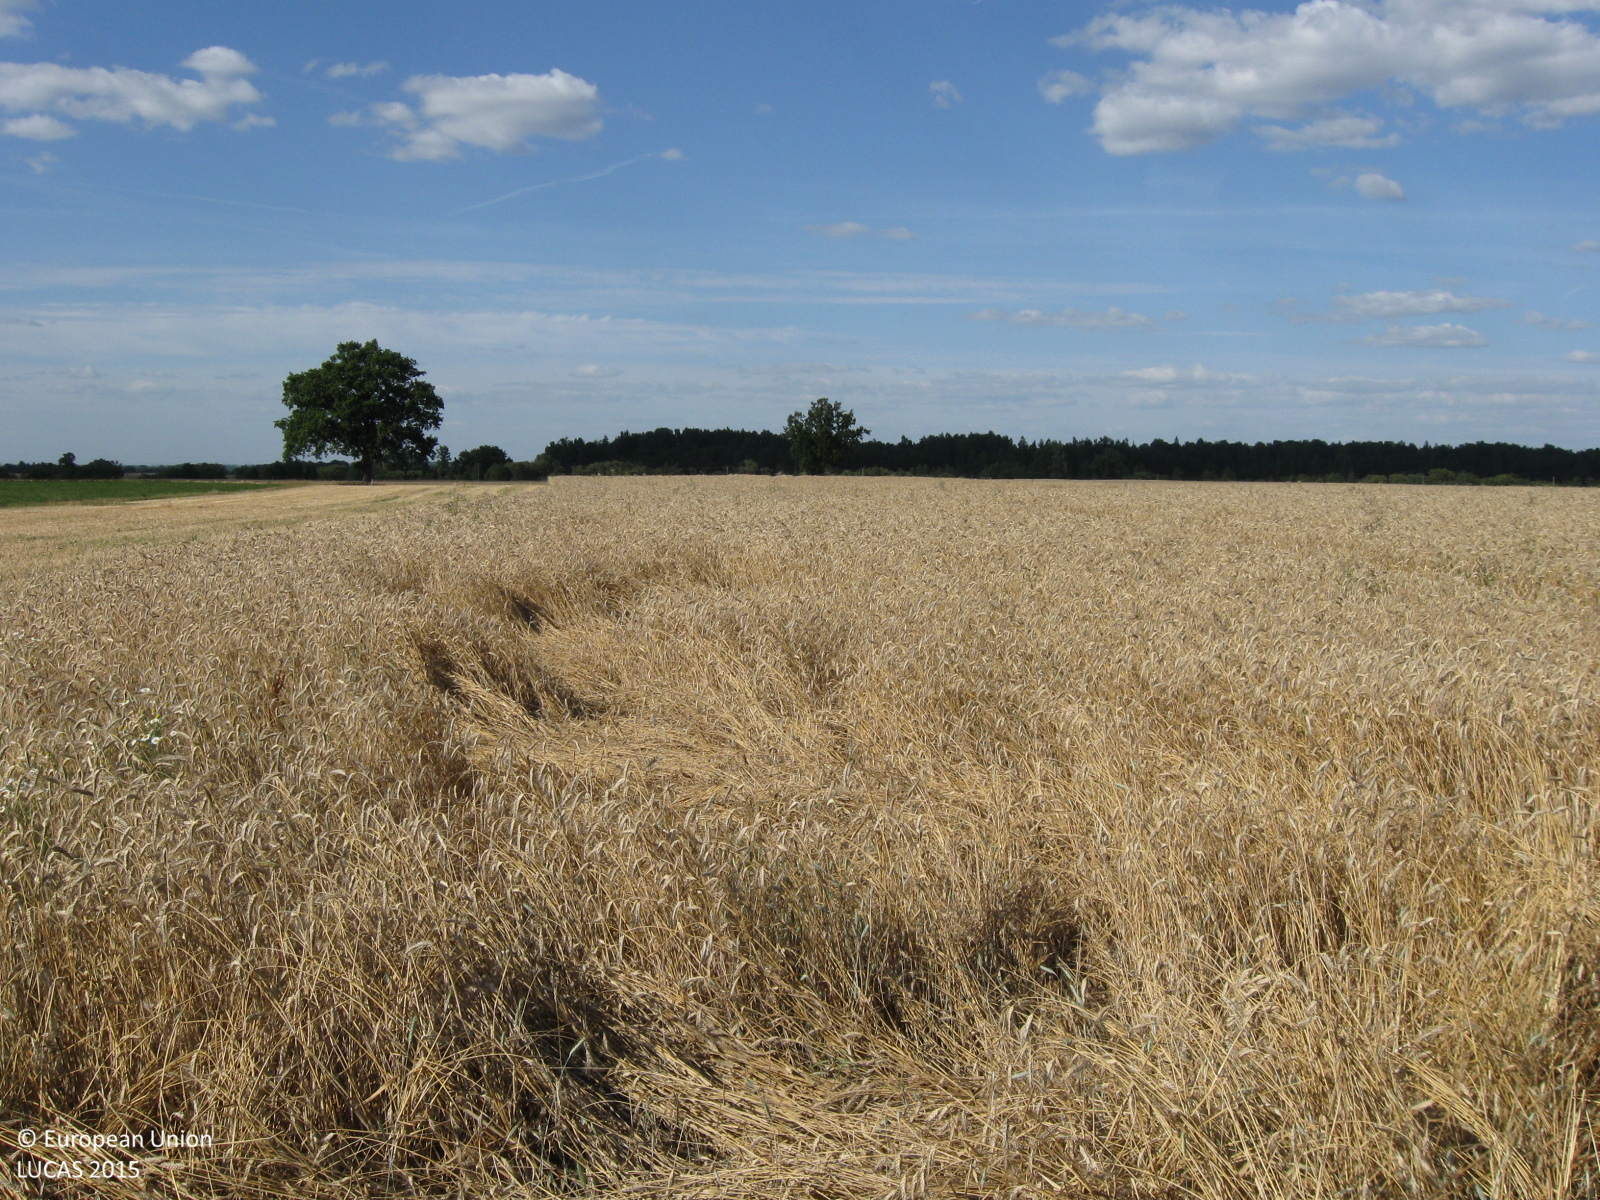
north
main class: Cropland
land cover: Triticale
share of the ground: > 75 %
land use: Agriculture (excluding fallow land and kitchen gardens)
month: August
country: LT
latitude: 55.2390
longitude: 22.5657
